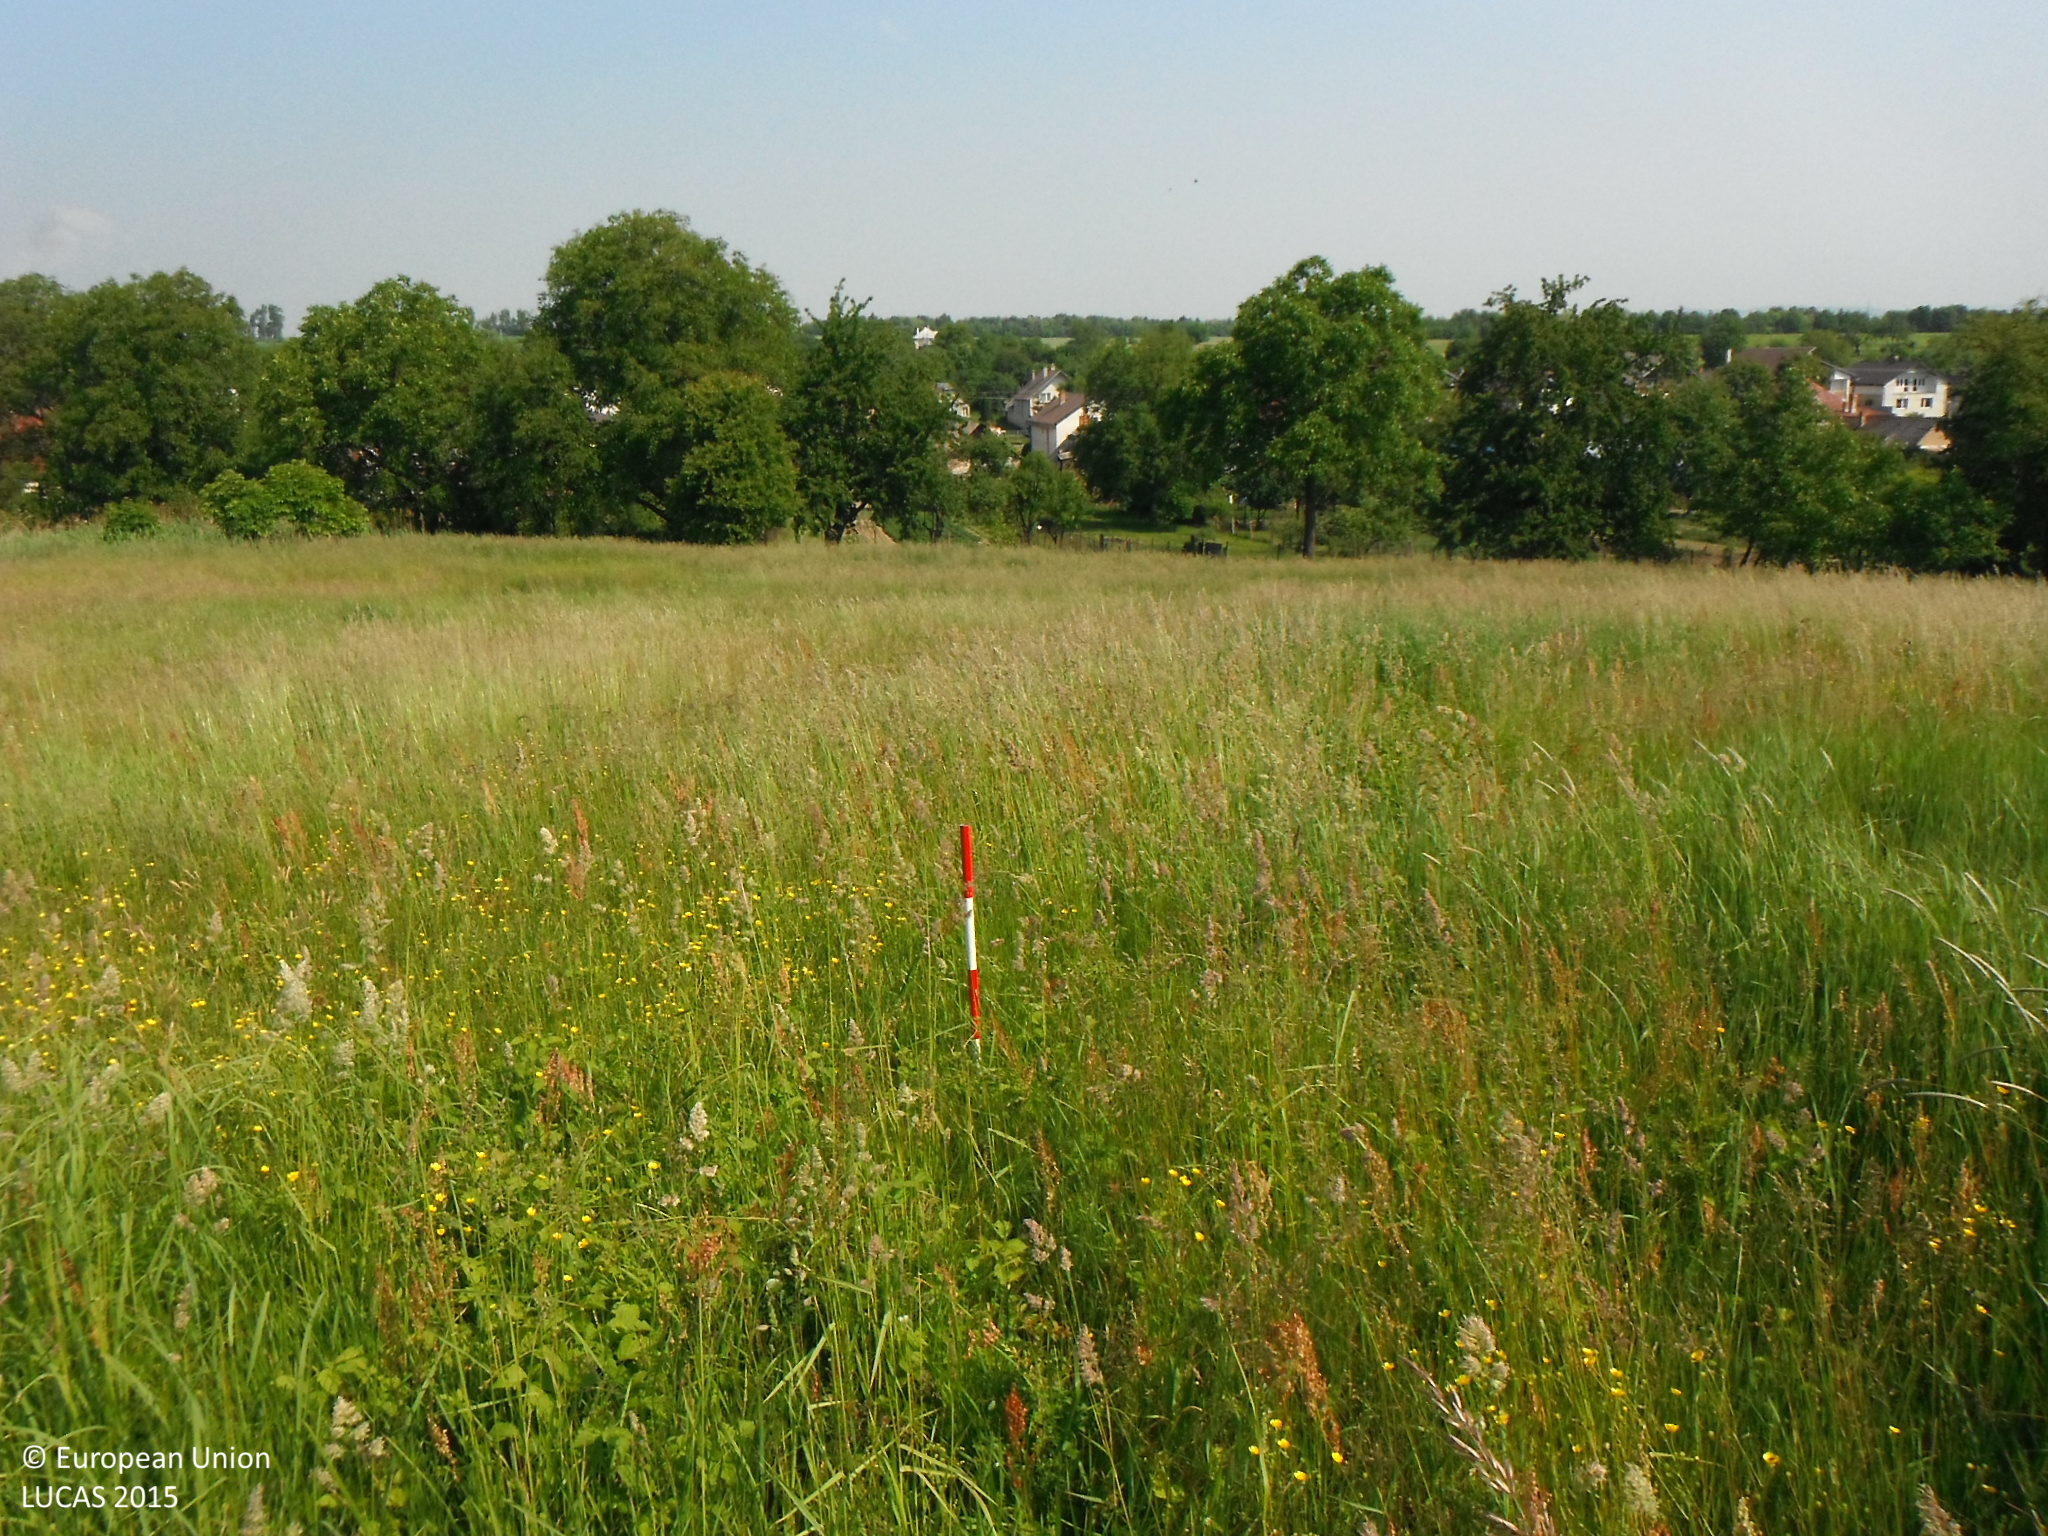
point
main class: Grassland
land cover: Spontaneously vegetated surfaces
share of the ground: > 75 %
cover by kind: herbaceous plants 95 %, shrubs 5 %
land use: Fallow land
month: June
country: SK
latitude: 48.8223
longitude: 21.6408
